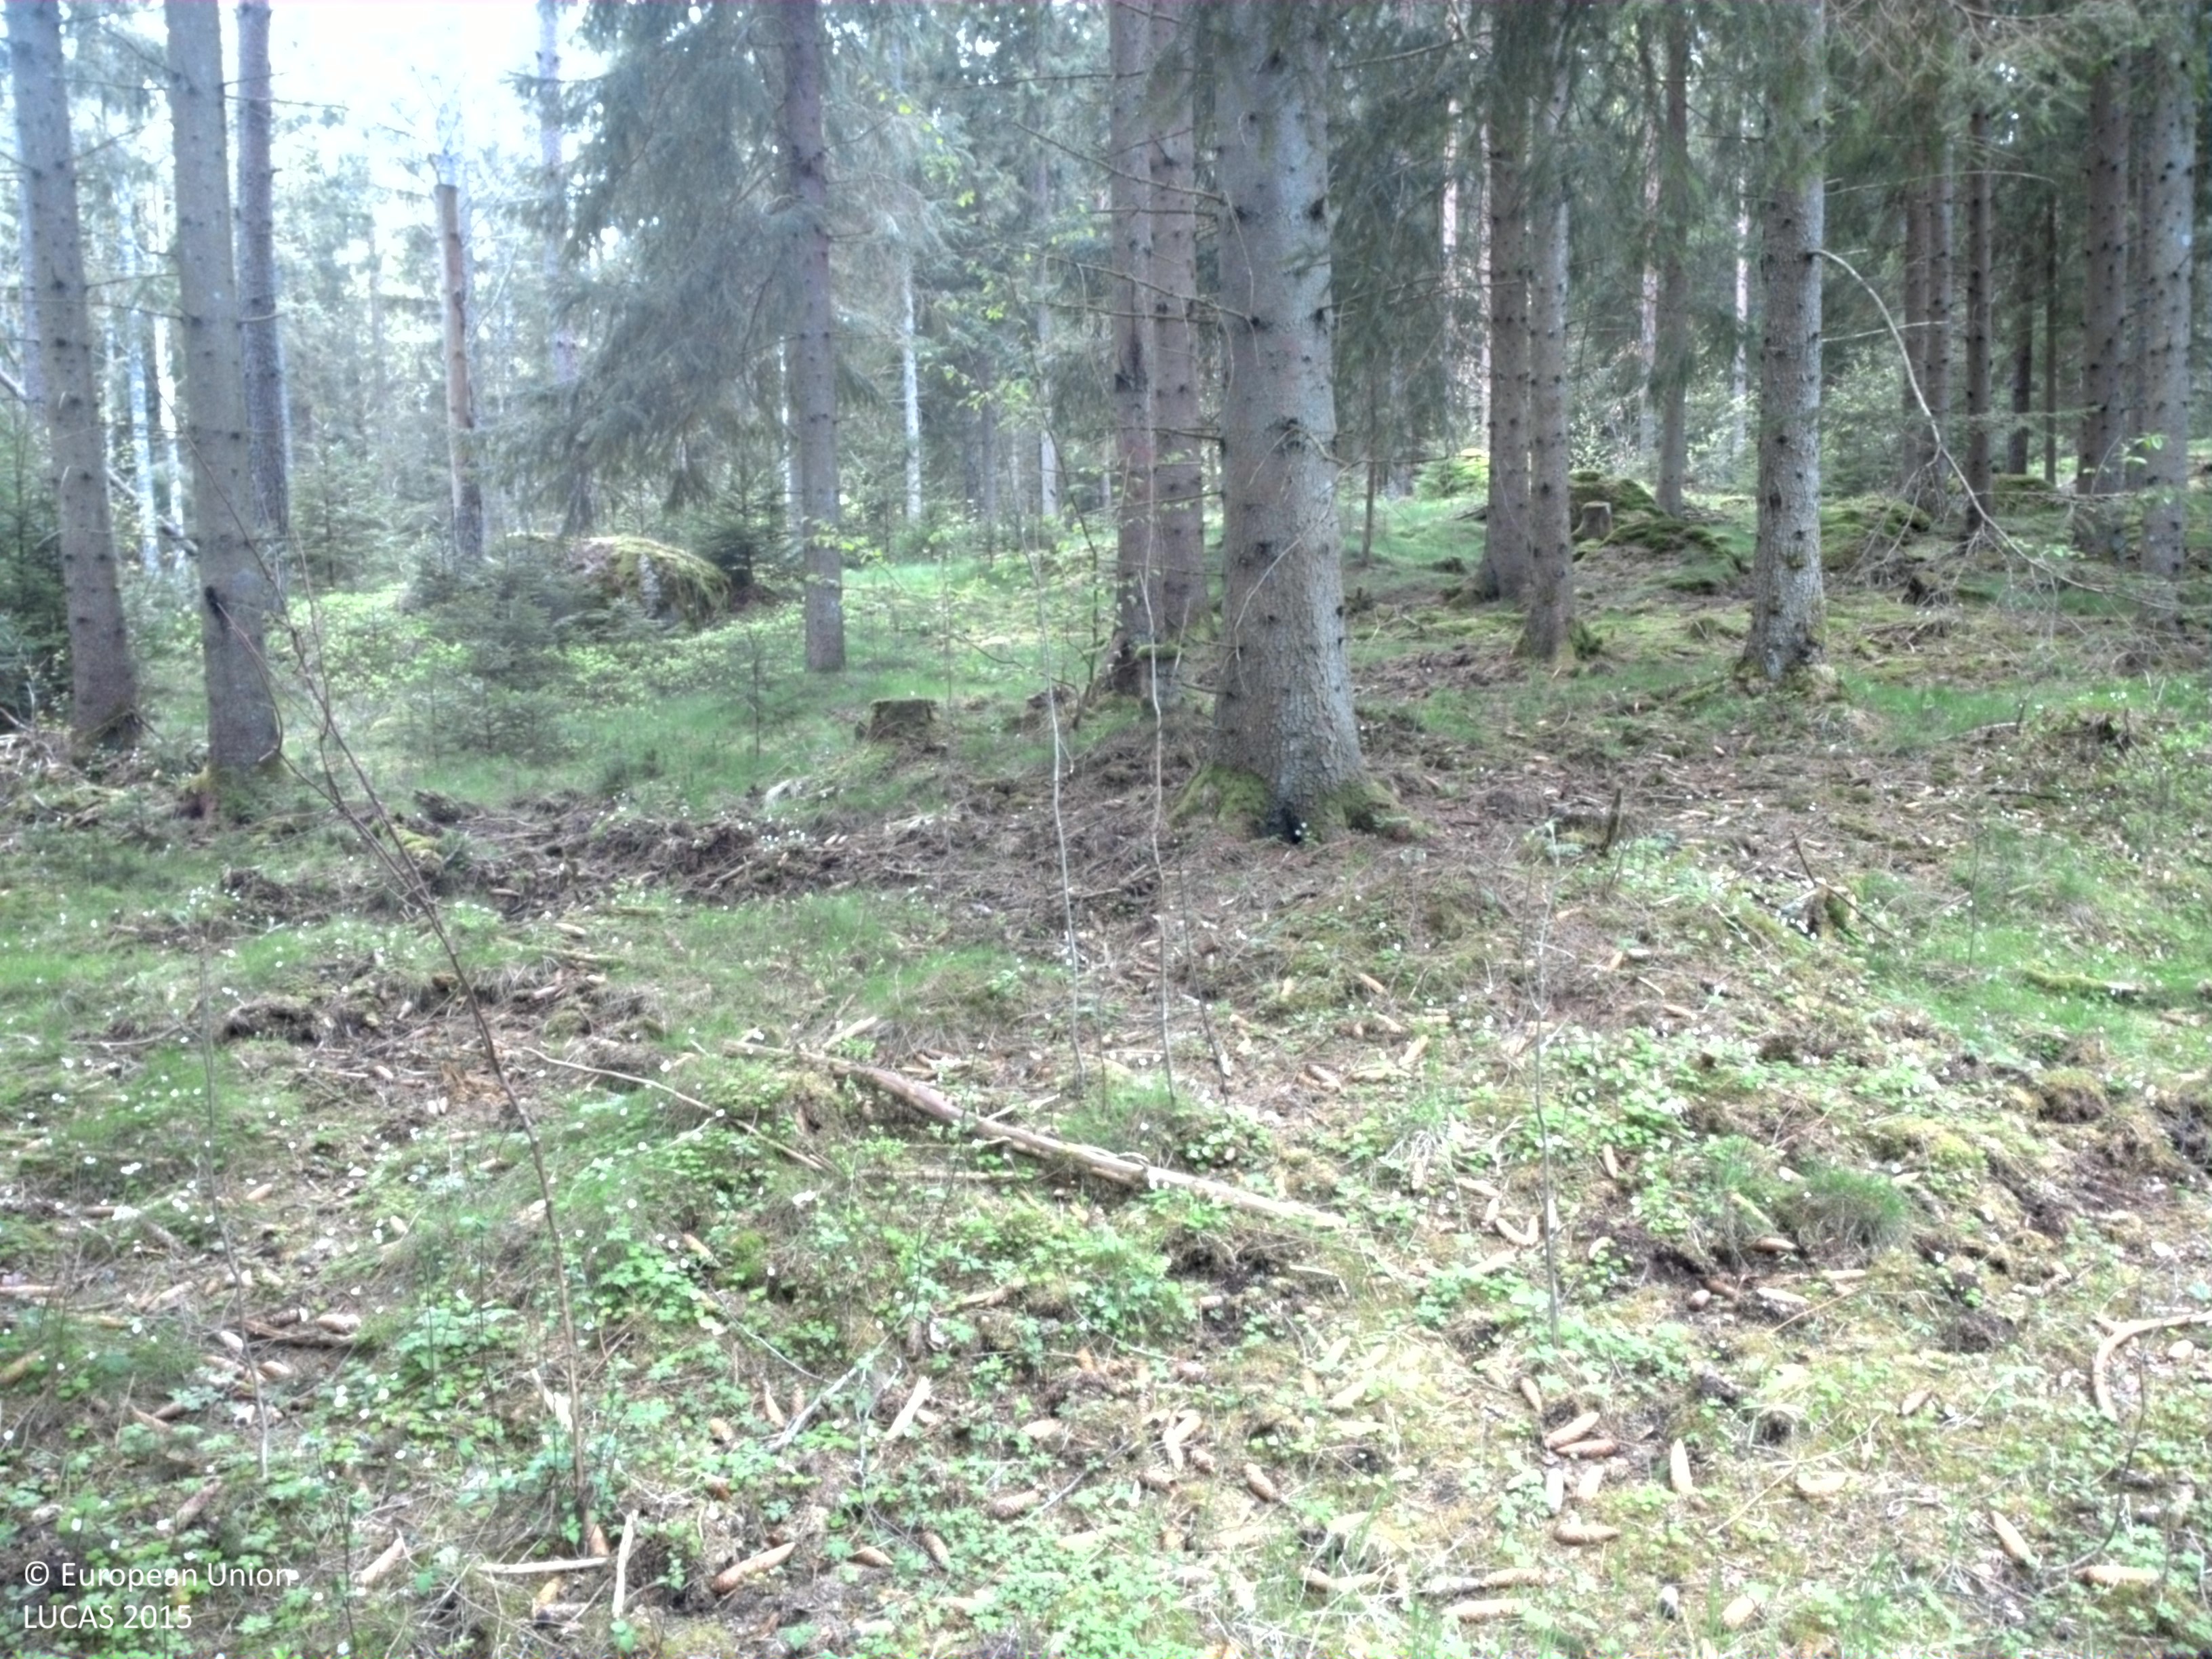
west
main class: Woodland
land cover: Spruce dominated mixed woodland
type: boreal forest
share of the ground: > 75 %
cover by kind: coniferous forest trees 75 %, broadleaved forest trees 25 %
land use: Forestry
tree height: > 5 m
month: May
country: SE
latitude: 56.4400
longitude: 15.2701
